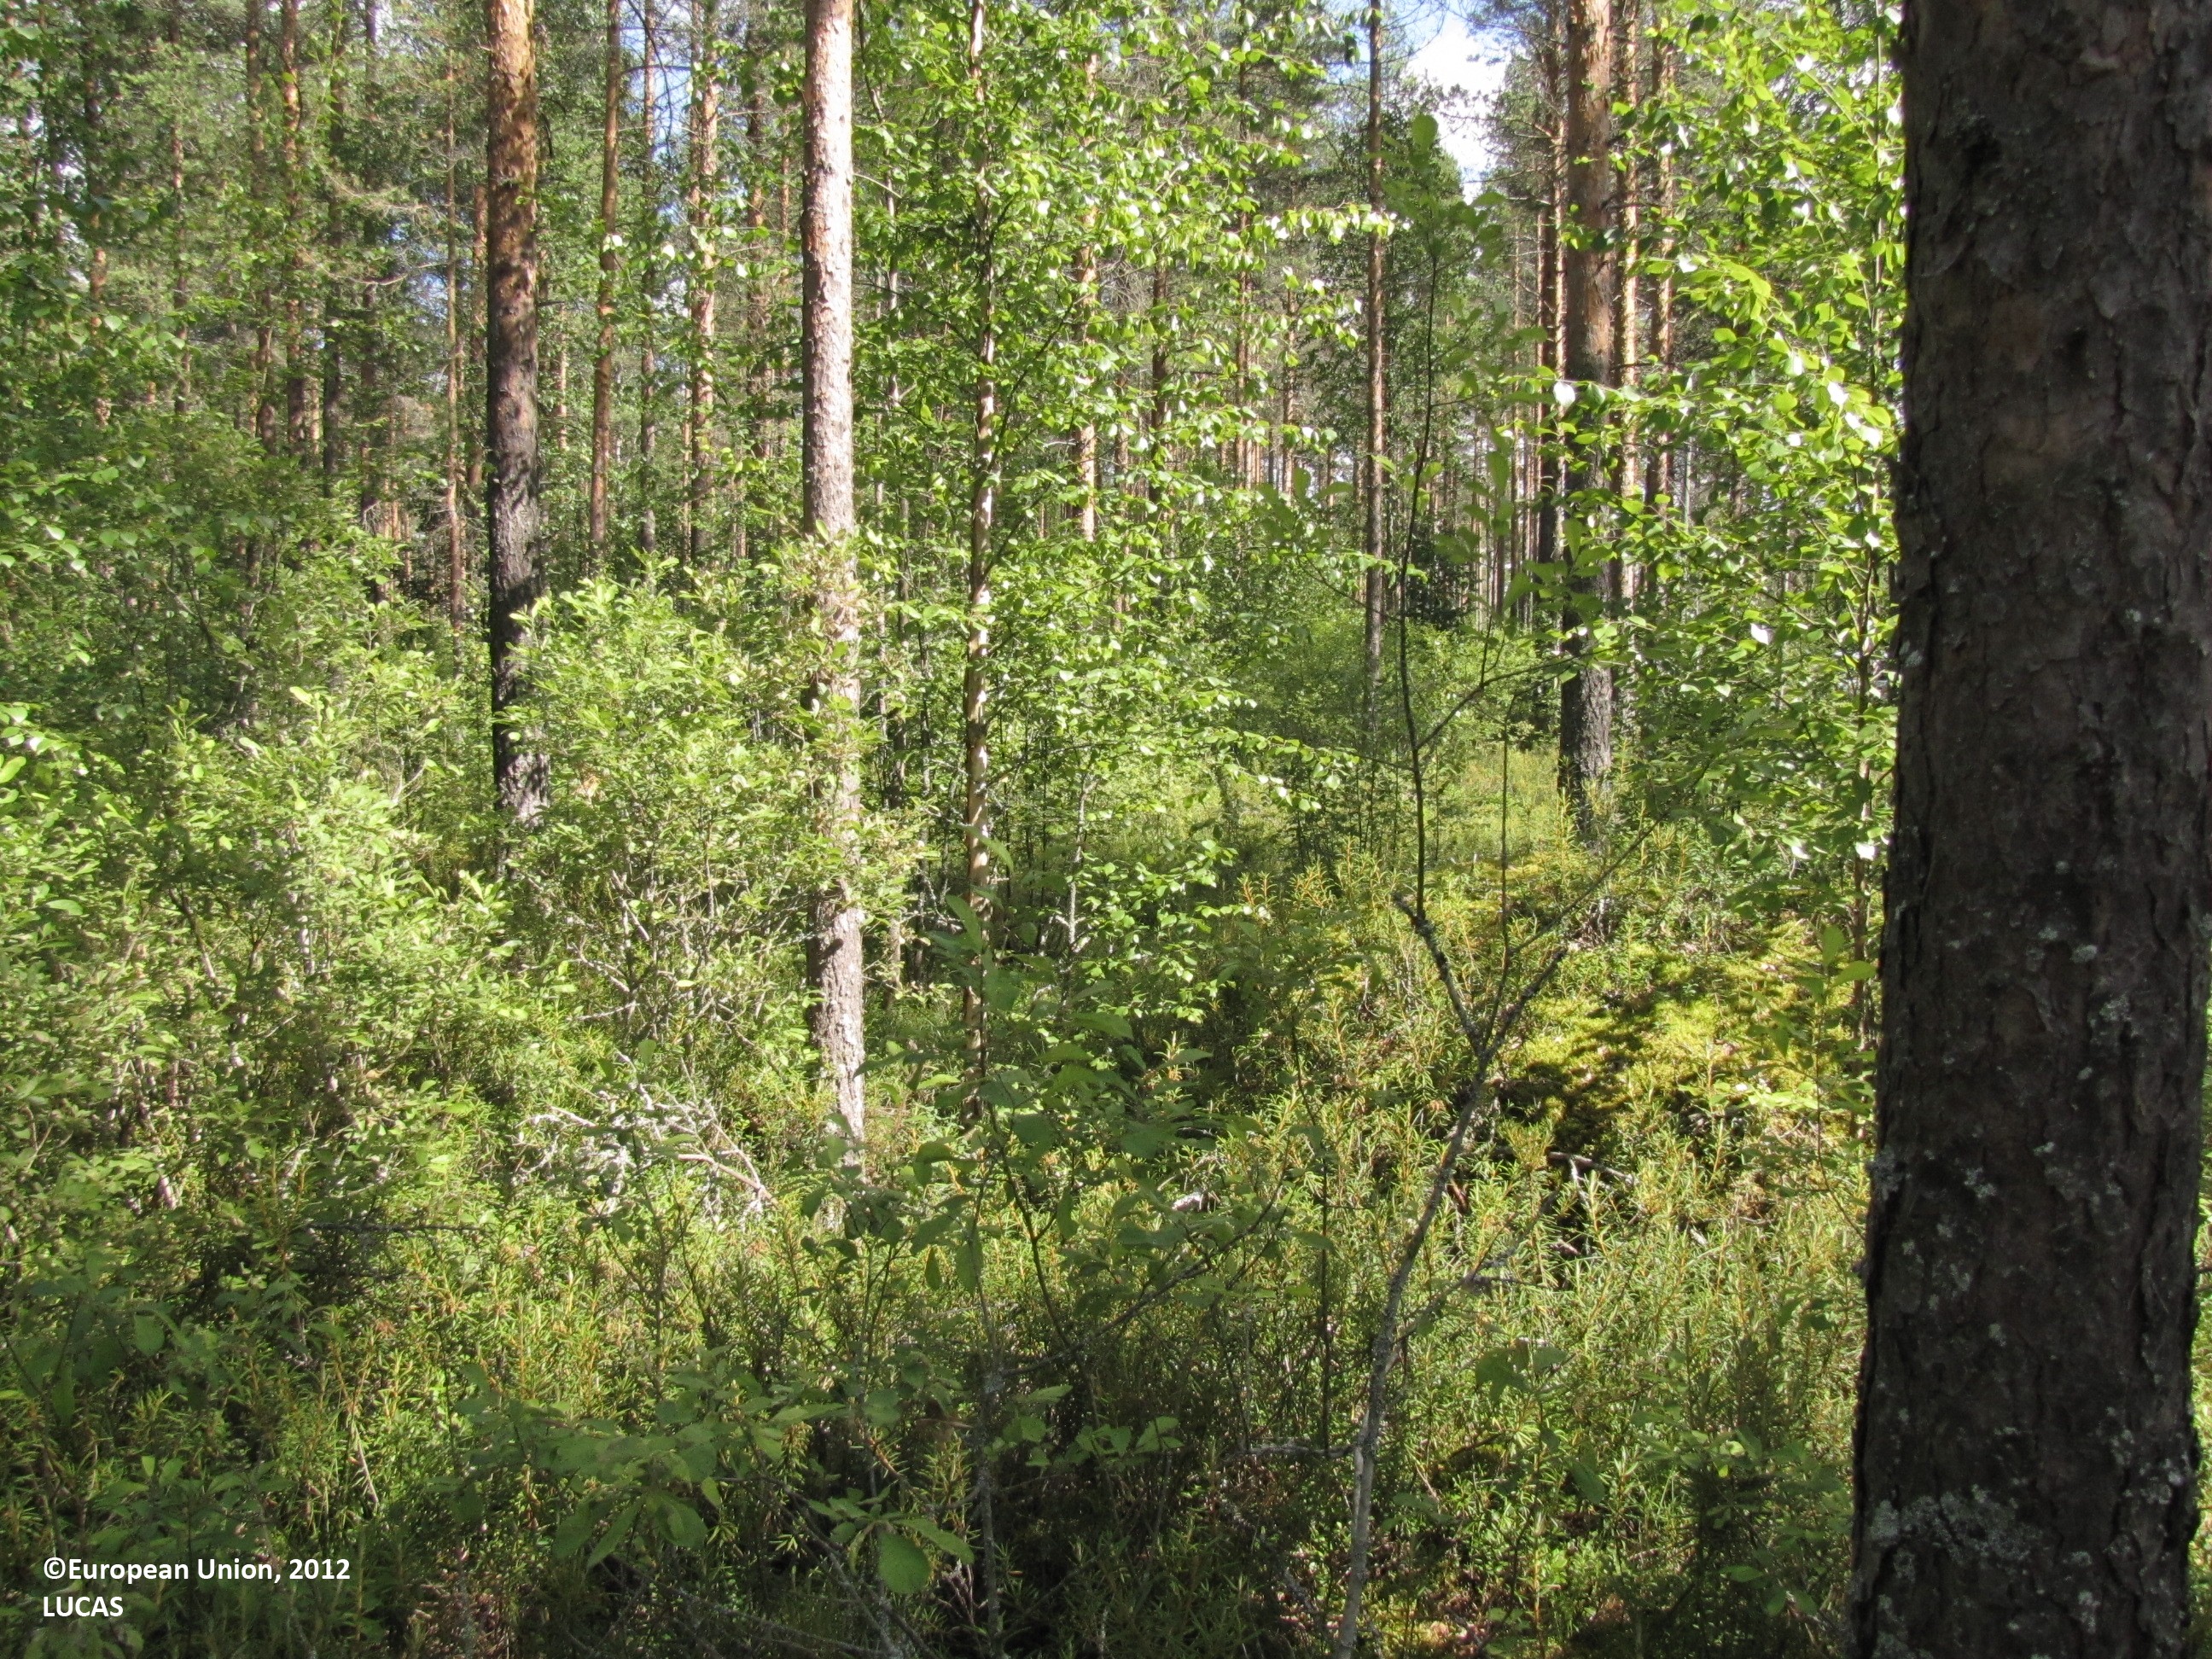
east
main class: Woodland
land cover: Pine dominated coniferous woodland
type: boreal forest
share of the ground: 50 - 75 %
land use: Forestry
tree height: > 5 m
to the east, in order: Pine dominated coniferous woodland; Ditches and canals; Grass margins; Tracks; Electric lines; Grass margins; Ditches and canals; Pine dominated coniferous woodland; Tracks; Pine dominated coniferous woodland; Pine dominated mixed woodland; Ditches and canals; Temporary grasslands
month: July
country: FI
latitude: 62.4398
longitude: 23.1035
